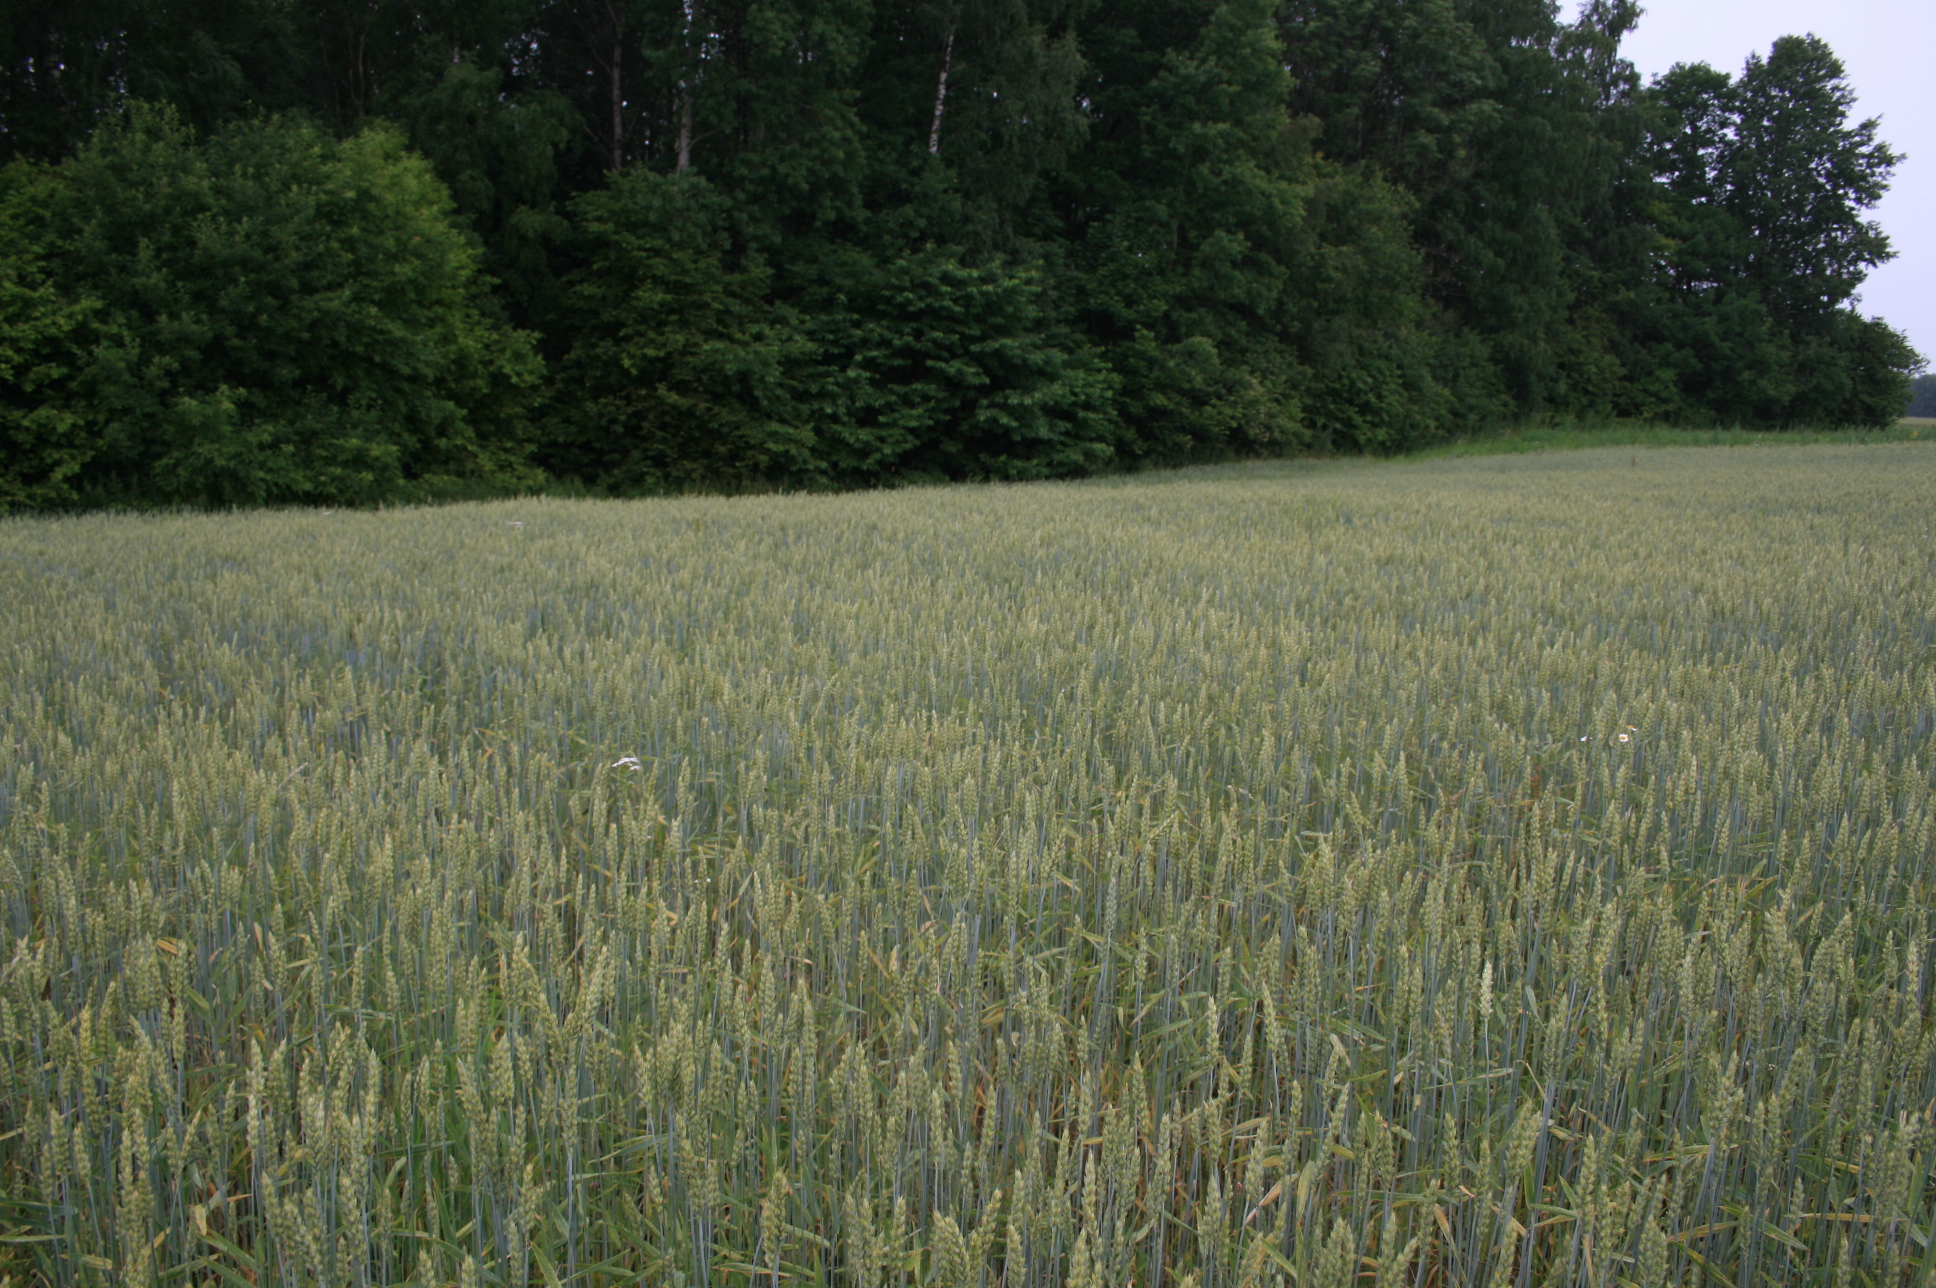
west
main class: Cropland
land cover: Common wheat
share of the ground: > 75 %
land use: Agriculture (excluding fallow land and kitchen gardens)
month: July
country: LT
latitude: 55.5238
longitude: 22.0769
